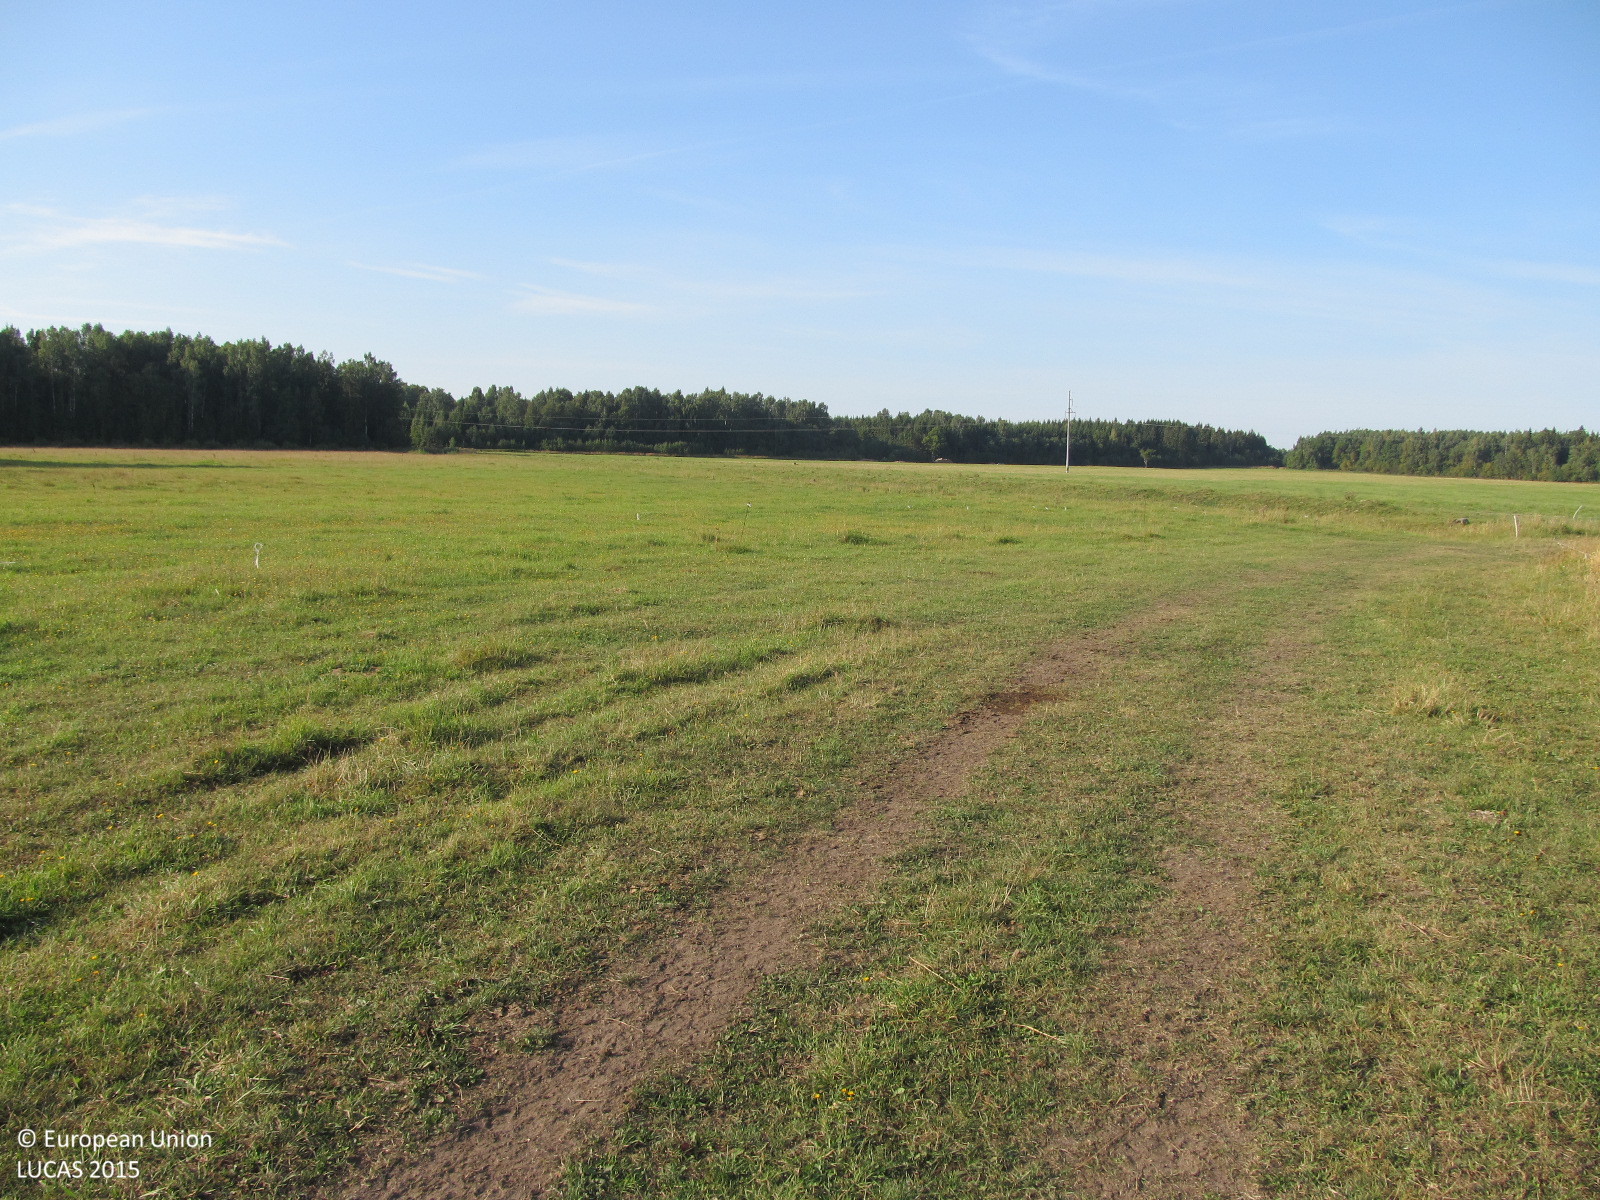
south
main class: Grassland
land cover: Grassland without tree/shrub cover
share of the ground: > 75 %
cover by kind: herbaceous plants 100 %
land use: Agriculture (excluding fallow land and kitchen gardens)
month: August
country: LT
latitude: 55.9160
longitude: 23.0776
